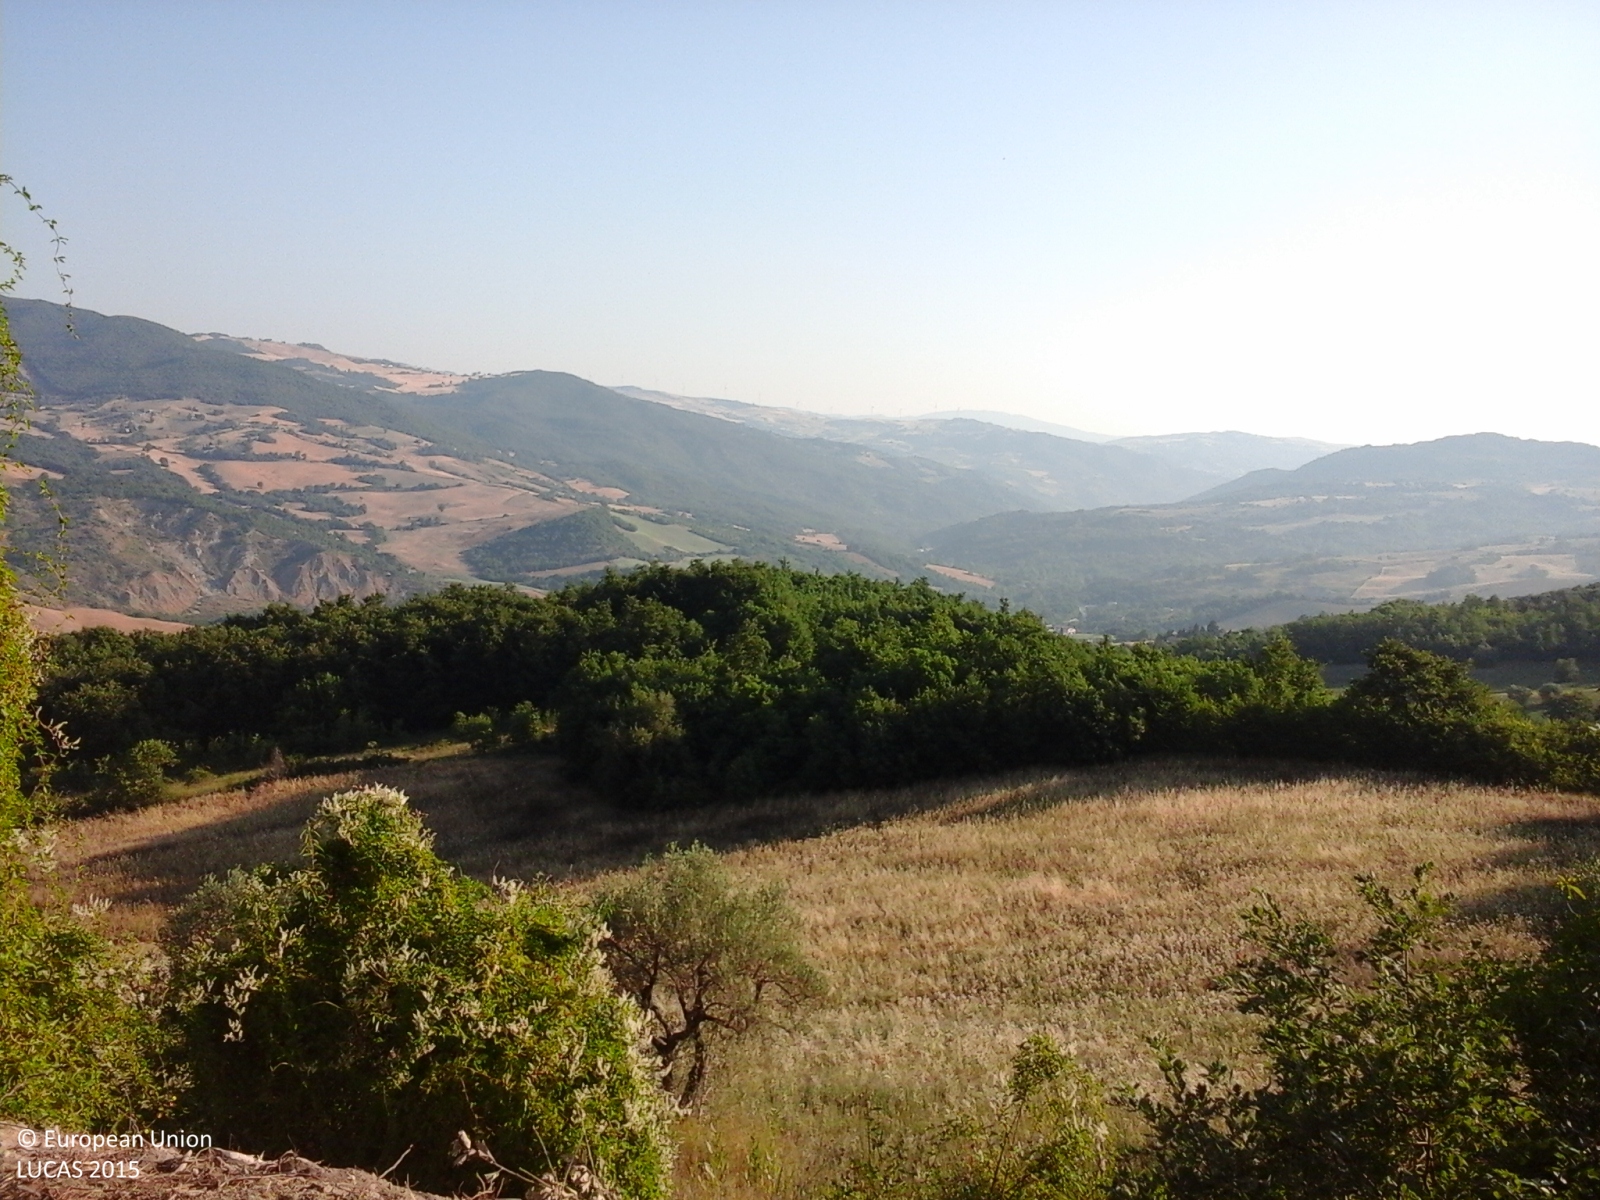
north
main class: Woodland
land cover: Broadleaved woodland
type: thermophilous deciduous forest
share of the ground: > 75 %
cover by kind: broadleaved forest trees 75 %, shrubs 15 %, herbaceous plants 10 %
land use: Semi-natural and natural areas not in use
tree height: > 5 m
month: July
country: IT
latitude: 41.6603
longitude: 14.6557
